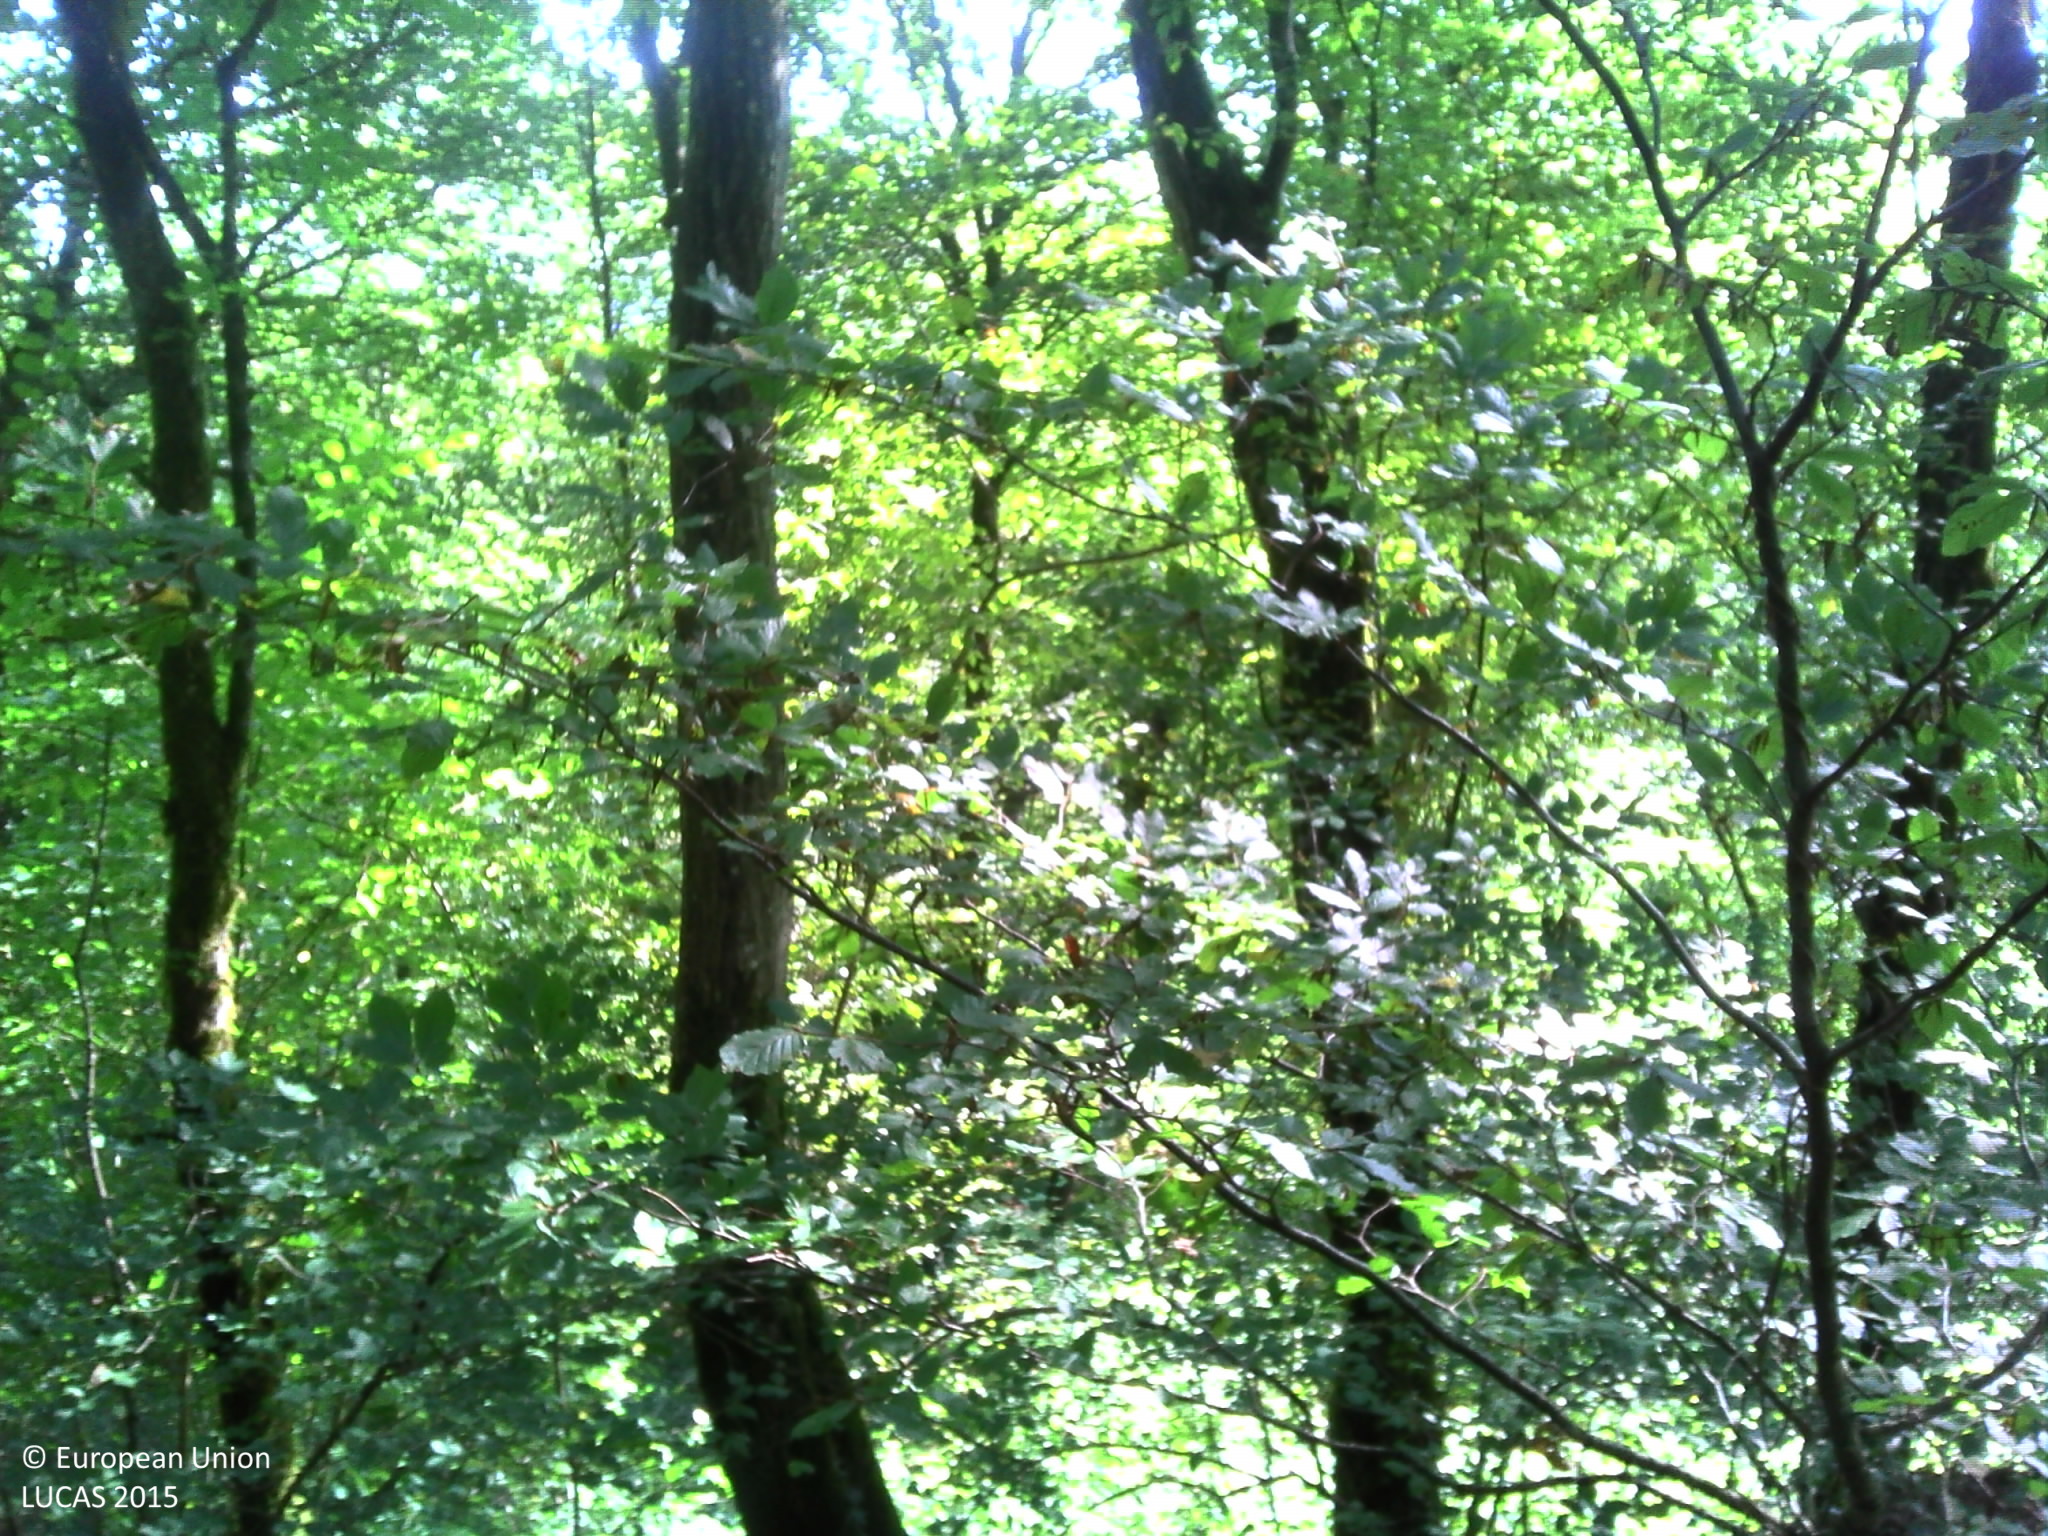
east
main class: Woodland
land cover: Broadleaved woodland
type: beech forest
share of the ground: > 75 %
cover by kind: broadleaved forest trees 100 %
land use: Forestry
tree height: > 5 m
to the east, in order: Broadleaved woodland; Dry stone walls; Fences; Broadleaved woodland; Grassland without tree/shrub cover; Broadleaved woodland; Grassland without tree/shrub cover; Broadleaved woodland; Grassland without tree/shrub cover
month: September
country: FR
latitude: 47.3879
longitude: 6.3322
